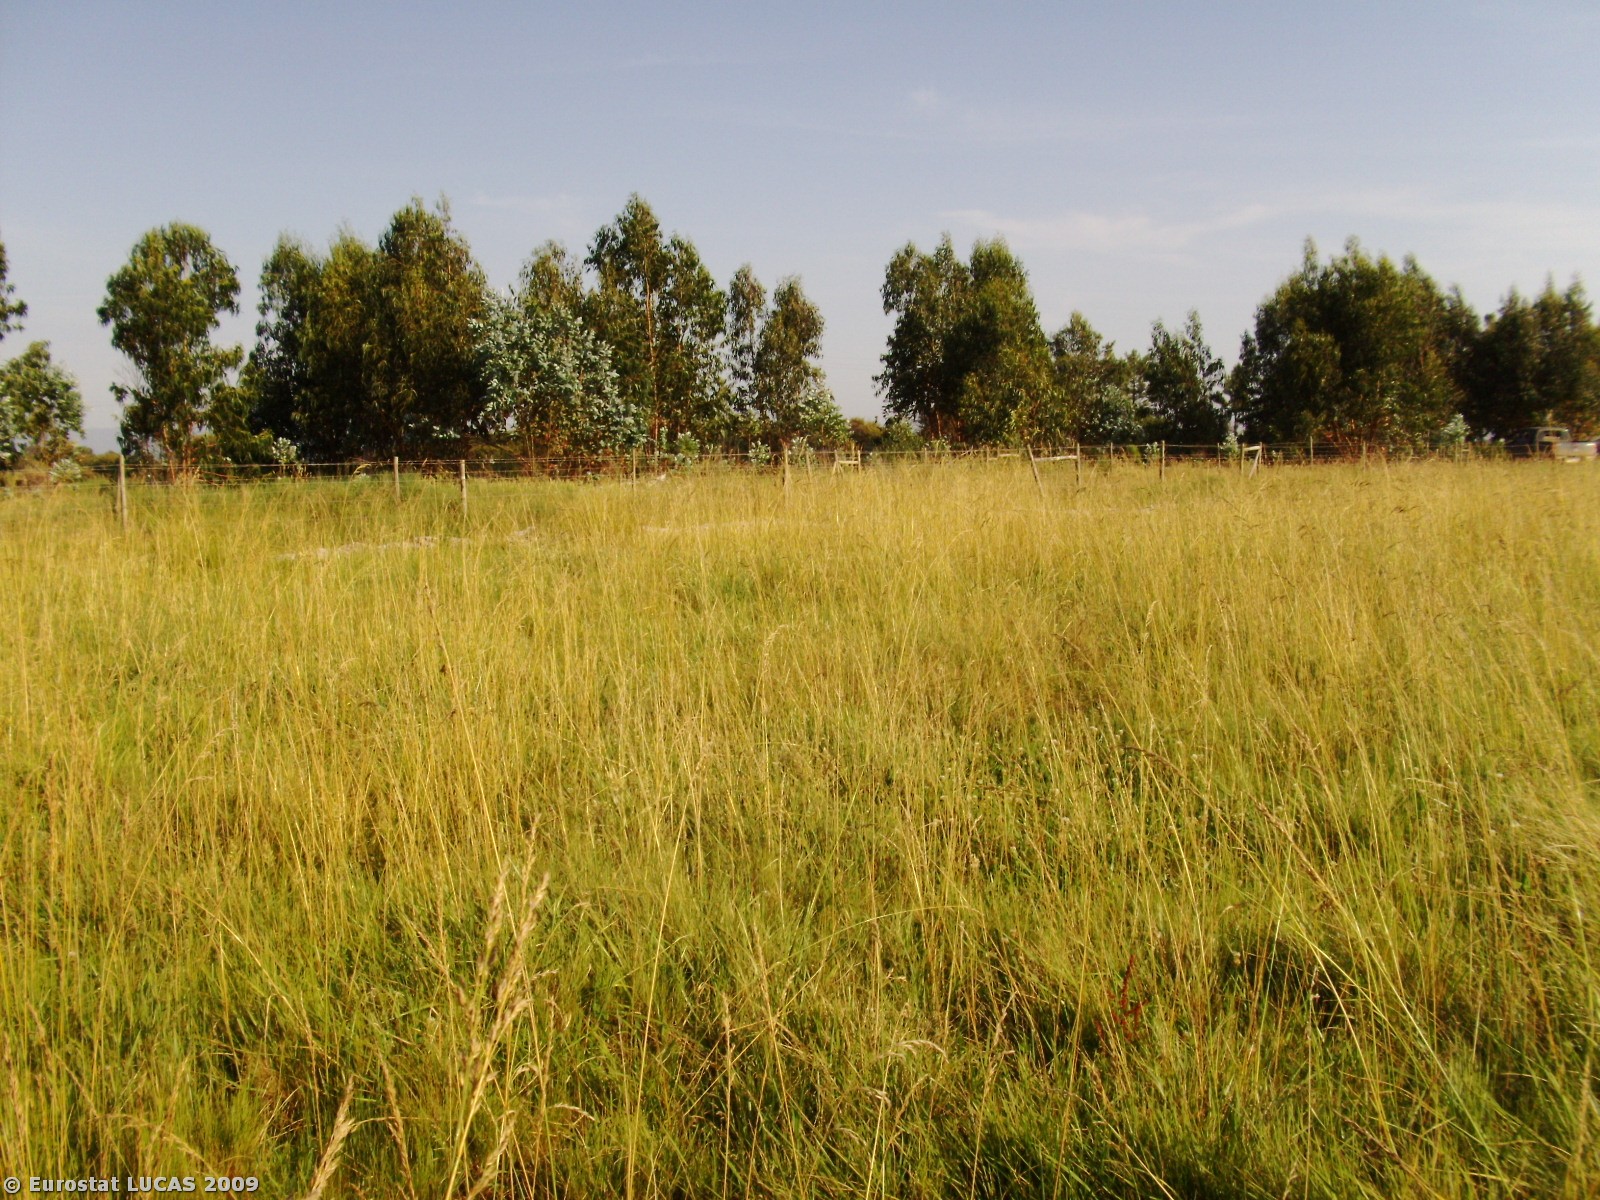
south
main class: Cropland
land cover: Temporary grasslands
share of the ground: > 75 %
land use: Agriculture (excluding fallow land and kitchen gardens)
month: June
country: PT
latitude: 37.4772
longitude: -8.7533
